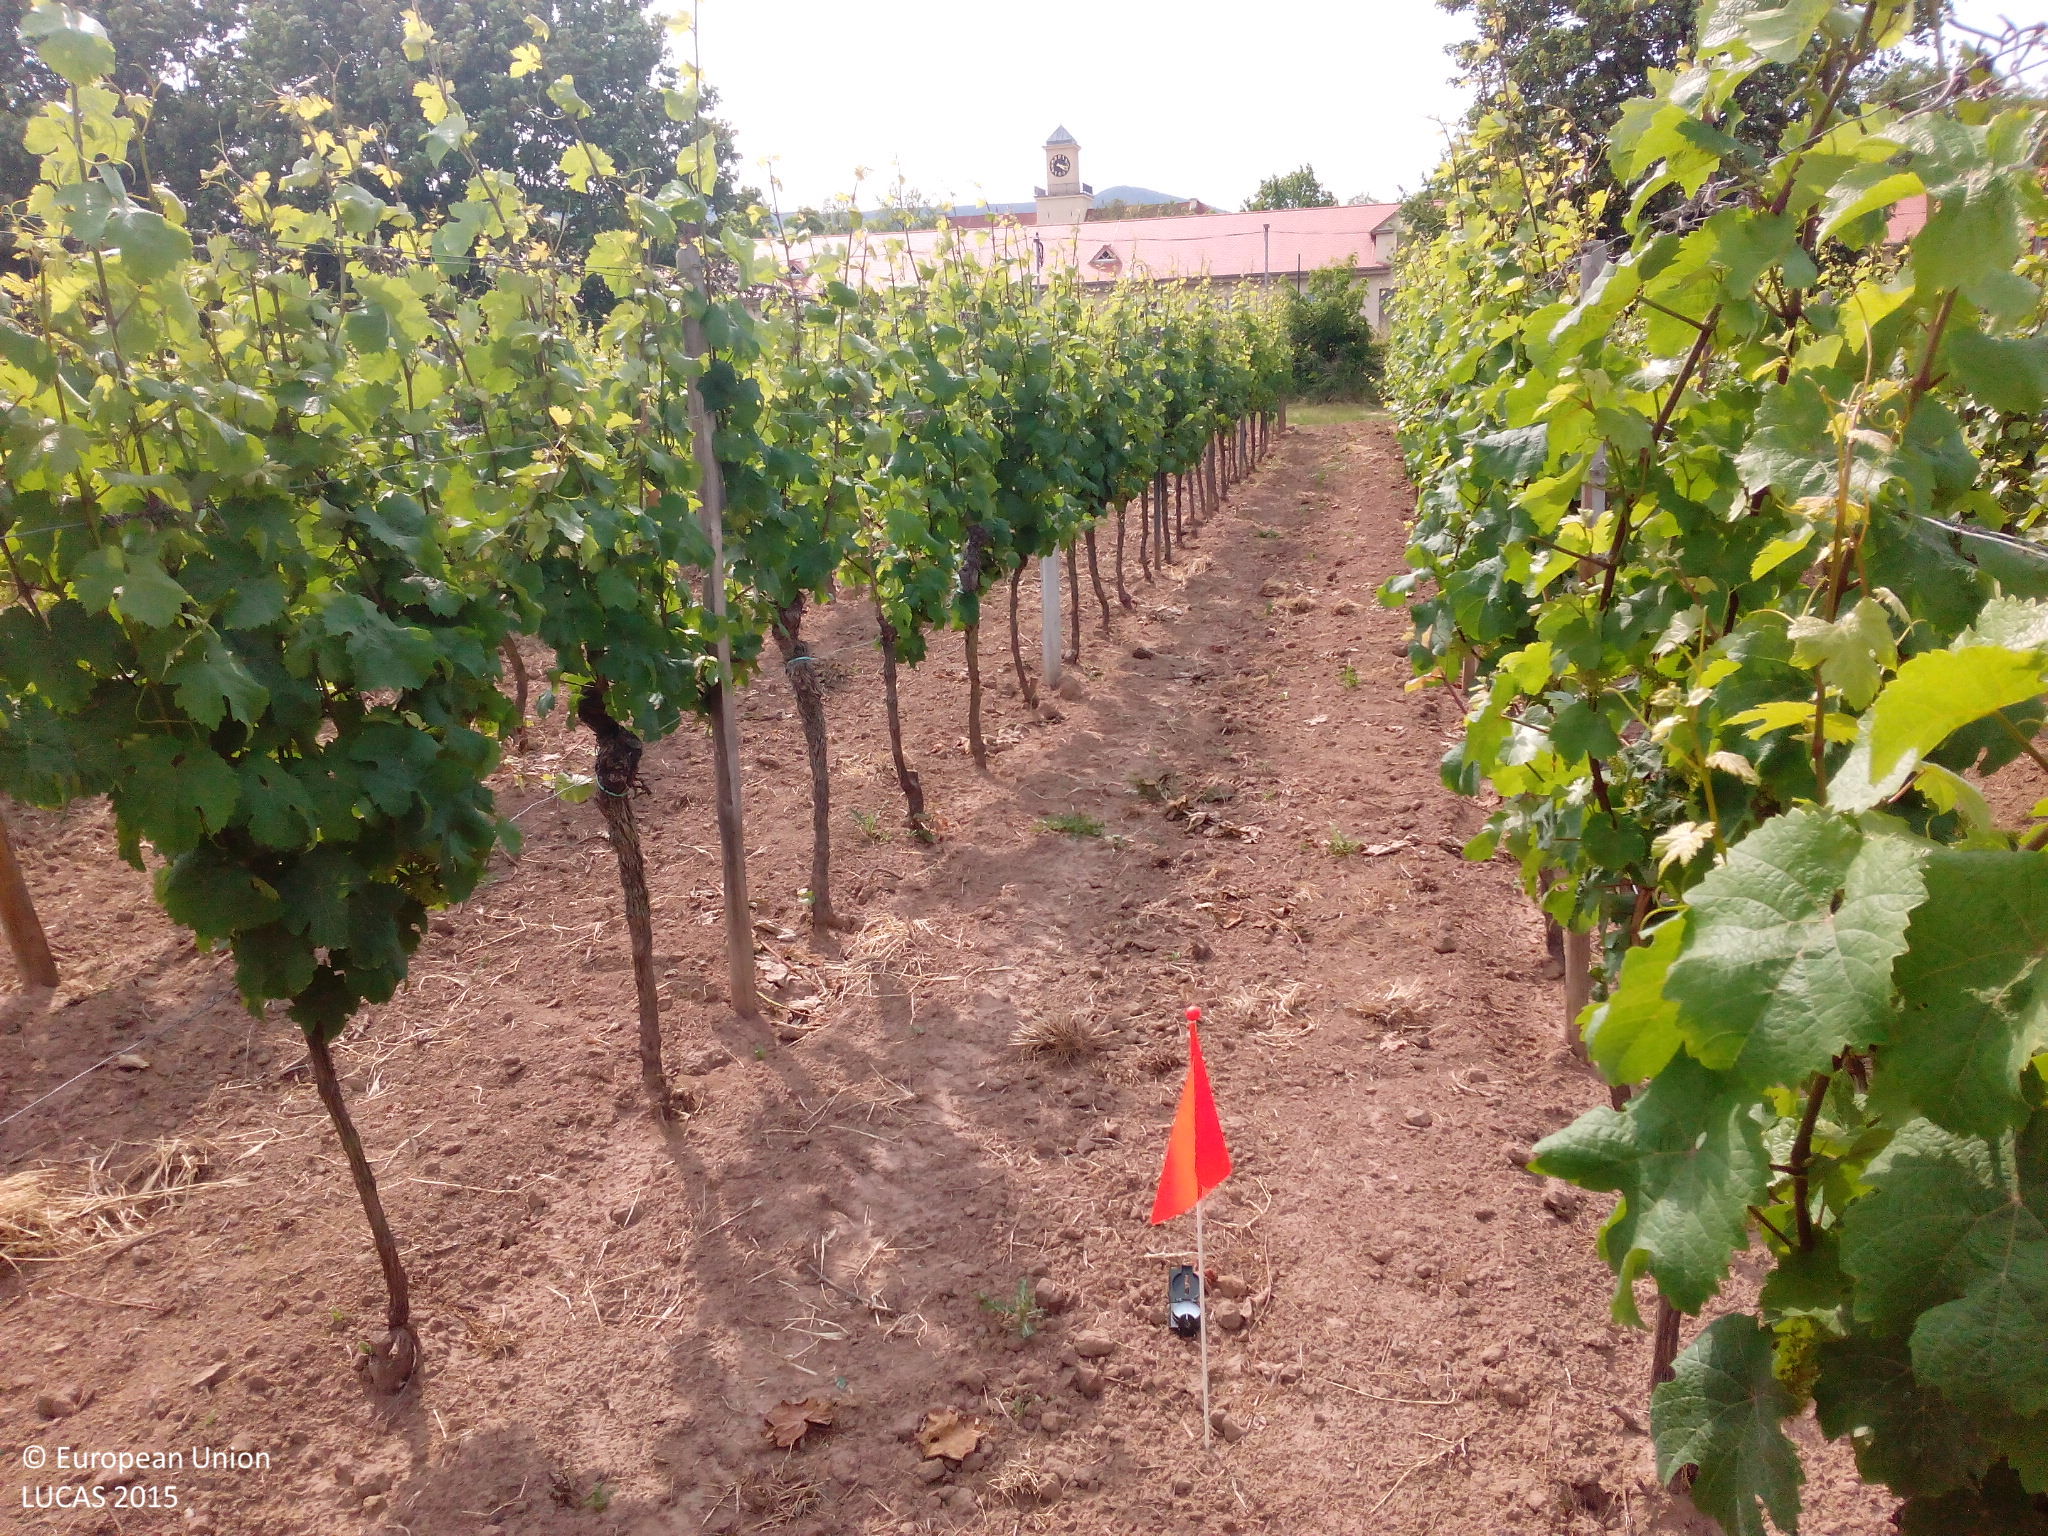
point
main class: Cropland
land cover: Vineyards
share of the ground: < 10 %
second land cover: Other bare soil
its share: > 75 %
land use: Agriculture (excluding fallow land and kitchen gardens)
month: June
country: DE
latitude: 49.3421
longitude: 8.1700
